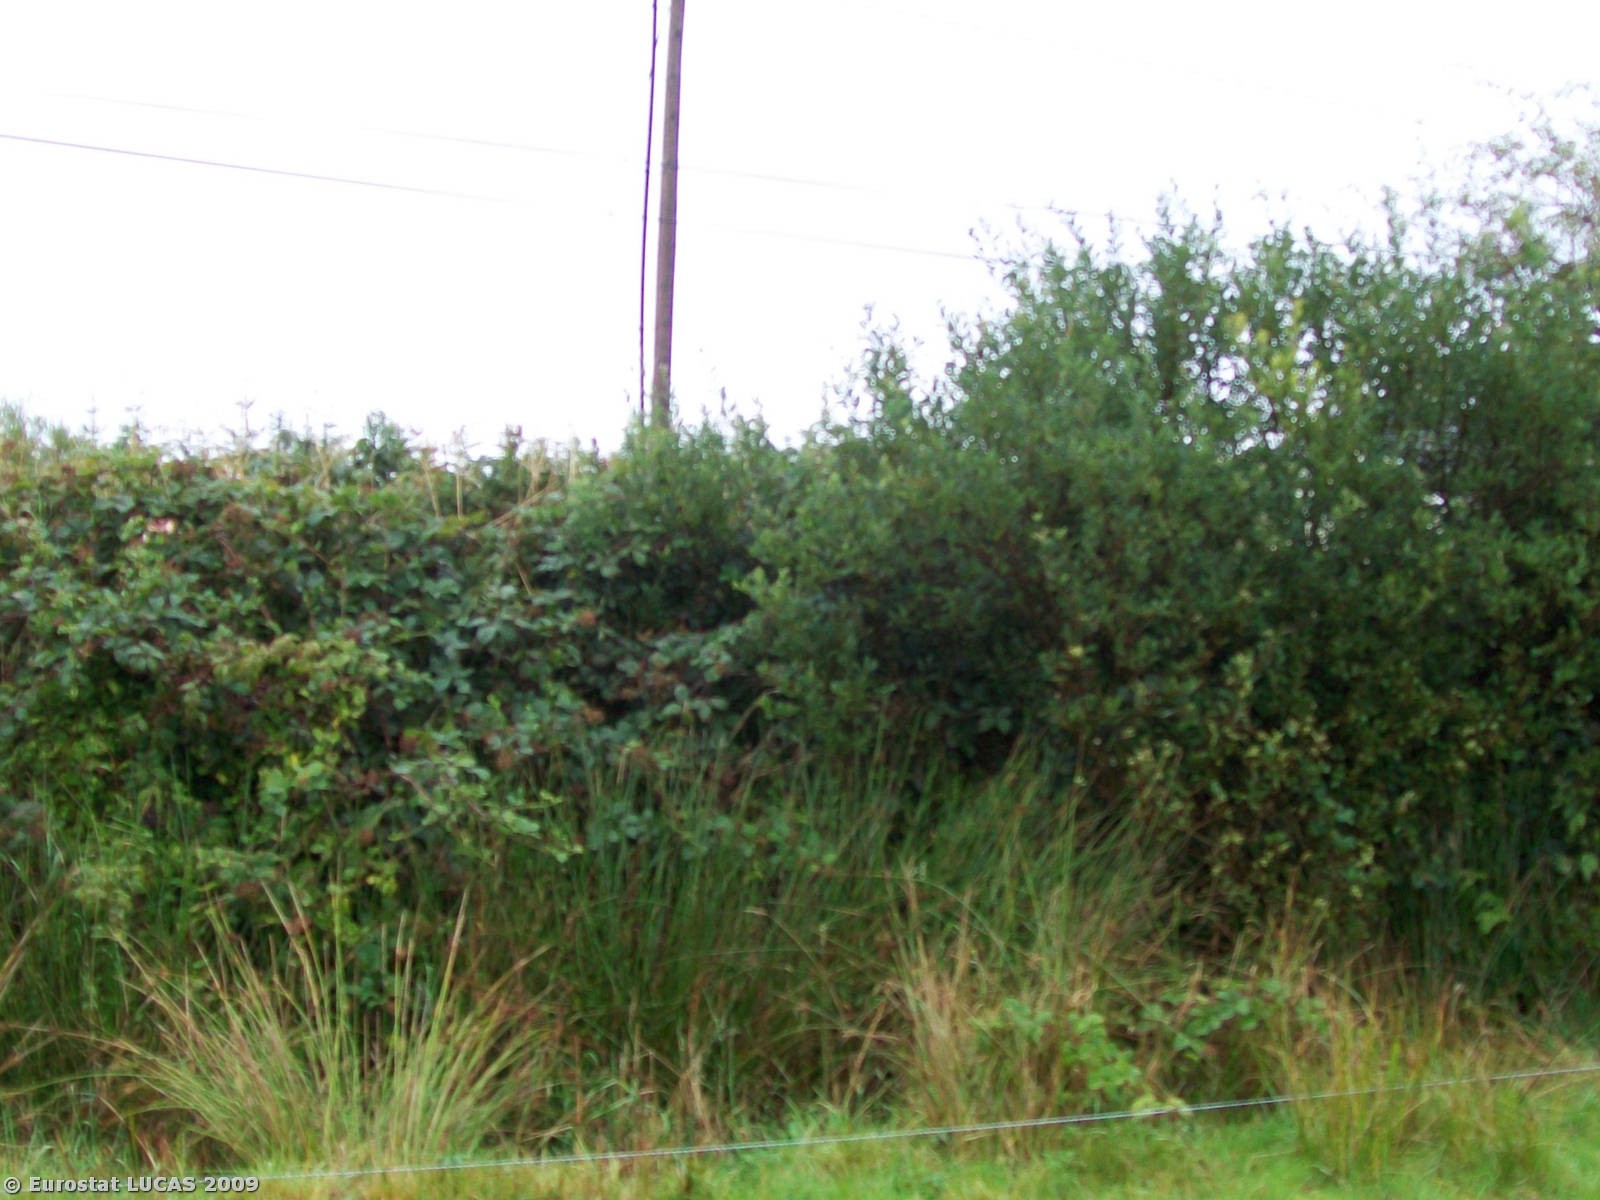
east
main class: Grassland
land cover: Grassland without tree/shrub cover
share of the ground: > 75 %
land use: Agriculture (excluding fallow land and kitchen gardens)
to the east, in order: Grassland without tree/shrub cover; Ditches and canals; Managed hedges; Grass margins; Paved roads, cycling and walking lanes; Artificial constructions in urban areas; Electric lines; Managed hedges; Coniferous woodland; Grassland without tree/shrub cover; Tracks; Grassland without tree/shrub cover
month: August
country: IE
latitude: 52.8338
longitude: -9.1442
